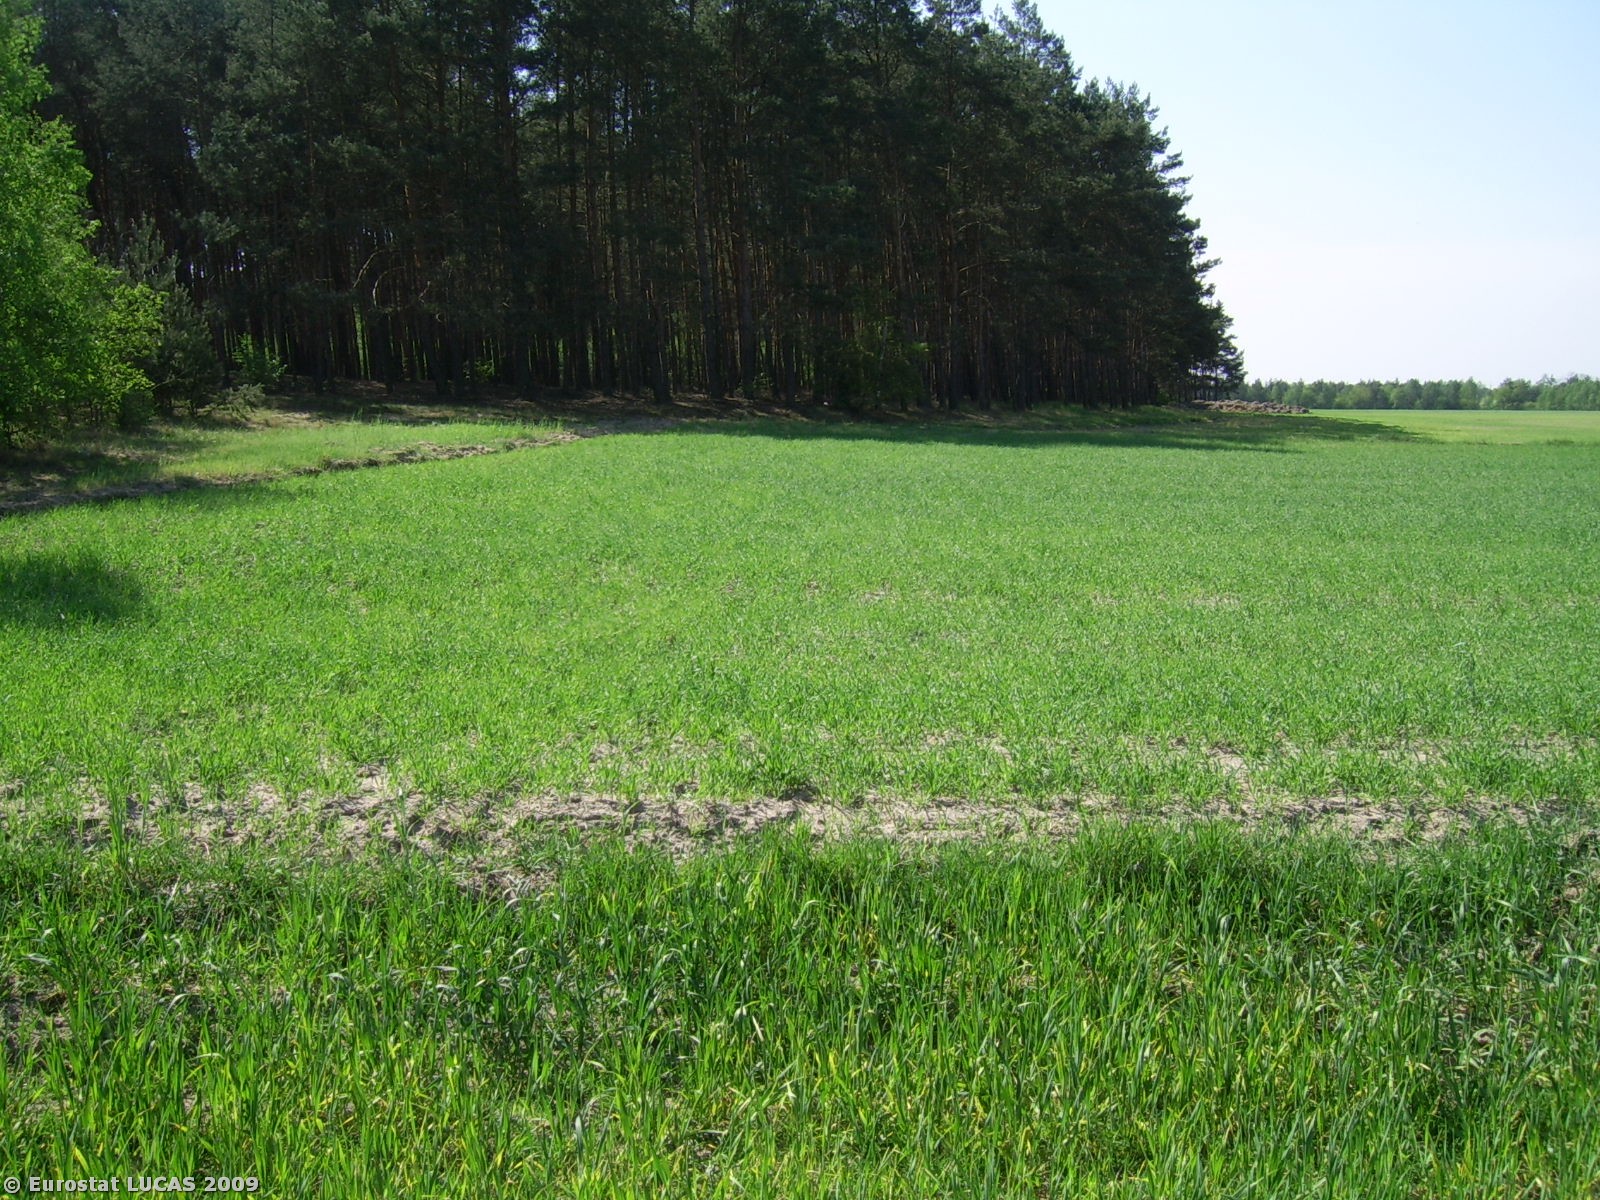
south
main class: Cropland
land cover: Common wheat
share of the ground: > 75 %
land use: Agriculture (excluding fallow land and kitchen gardens)
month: April
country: PL
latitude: 52.2109
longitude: 16.9318
